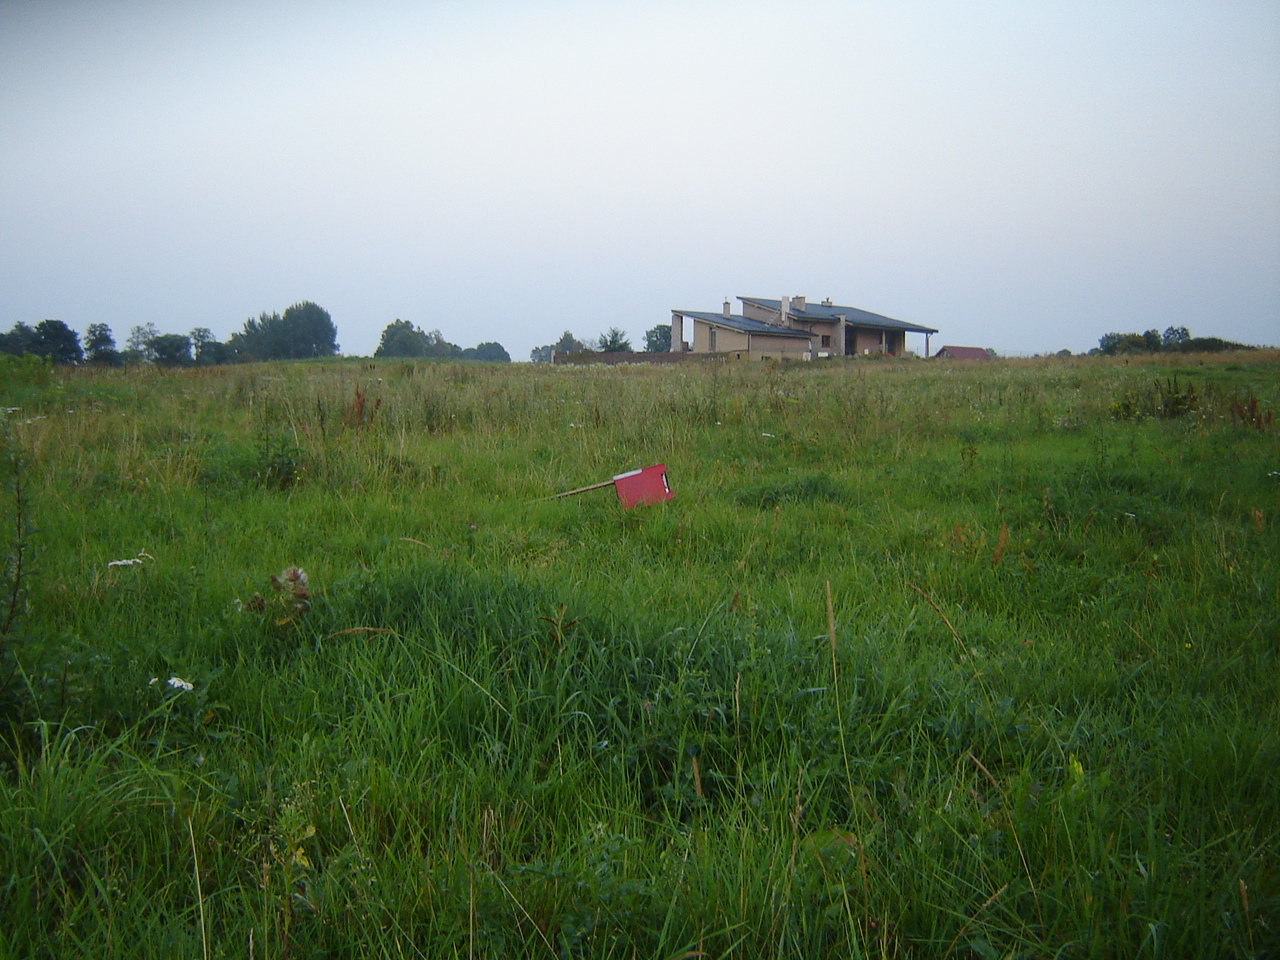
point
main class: Grassland
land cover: Grassland without tree/shrub cover
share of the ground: > 75 %
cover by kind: herbaceous plants 100 %
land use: Agriculture (excluding fallow land and kitchen gardens)
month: August
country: LT
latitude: 54.7989
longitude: 25.1917
